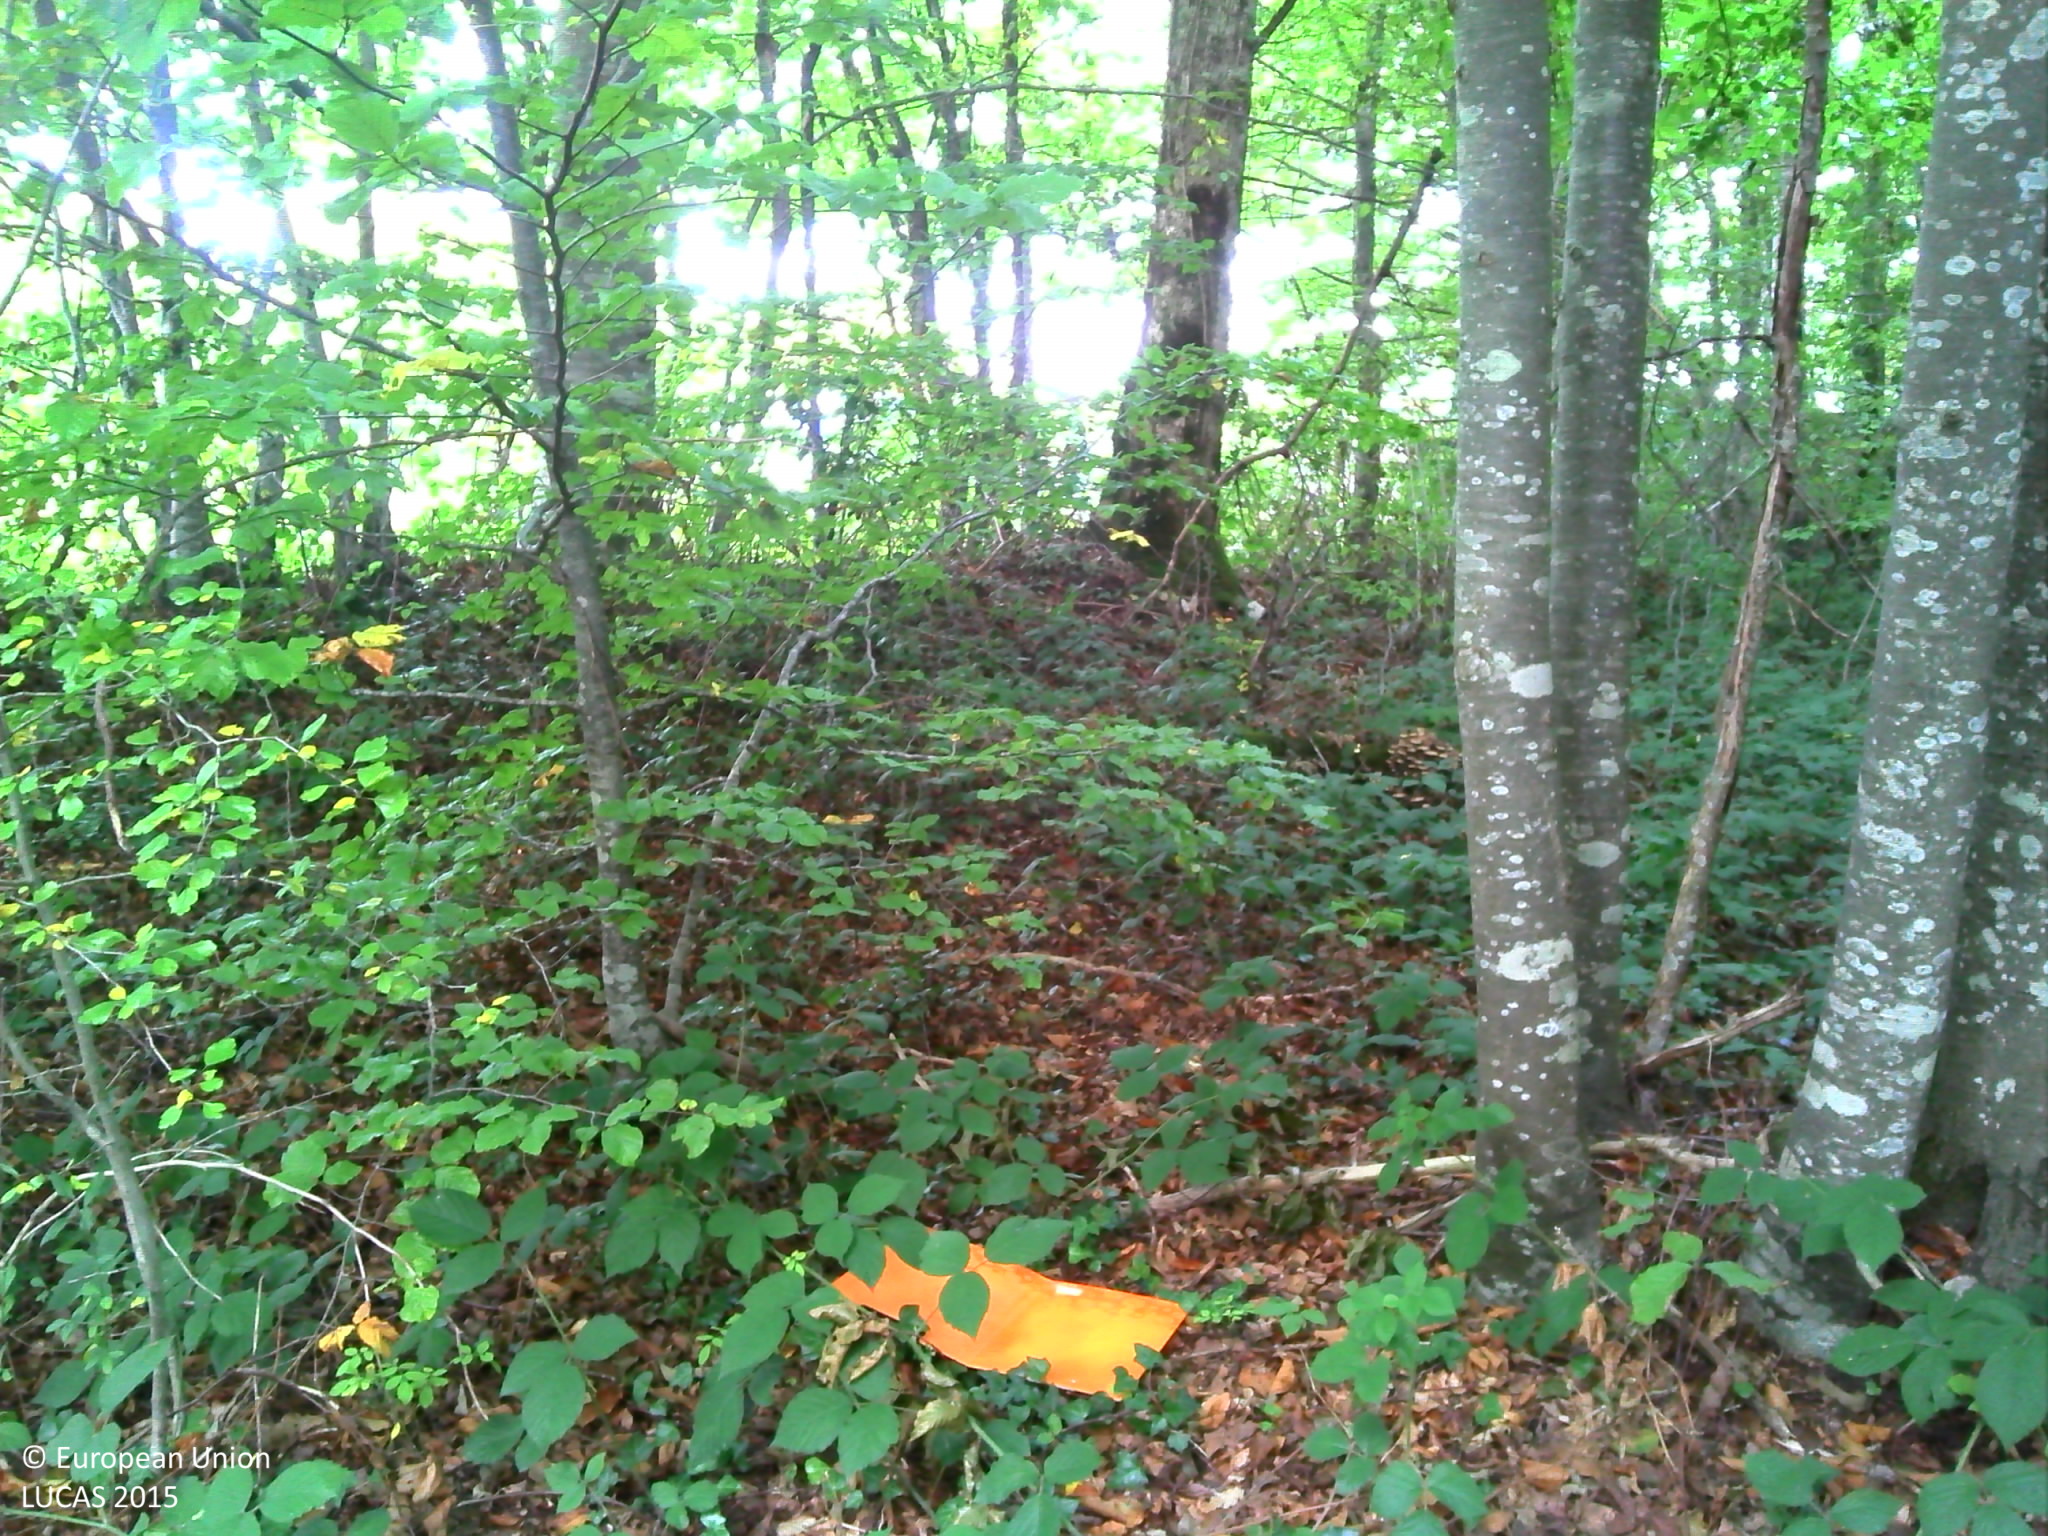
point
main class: Woodland
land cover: Broadleaved woodland
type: beech forest
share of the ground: > 75 %
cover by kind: broadleaved forest trees 90 %, herbaceous plants 5 %, unconsolidated bare surface 5 %
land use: Forestry
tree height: > 5 m
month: October
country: FR
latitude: 47.0749
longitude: 6.1434
